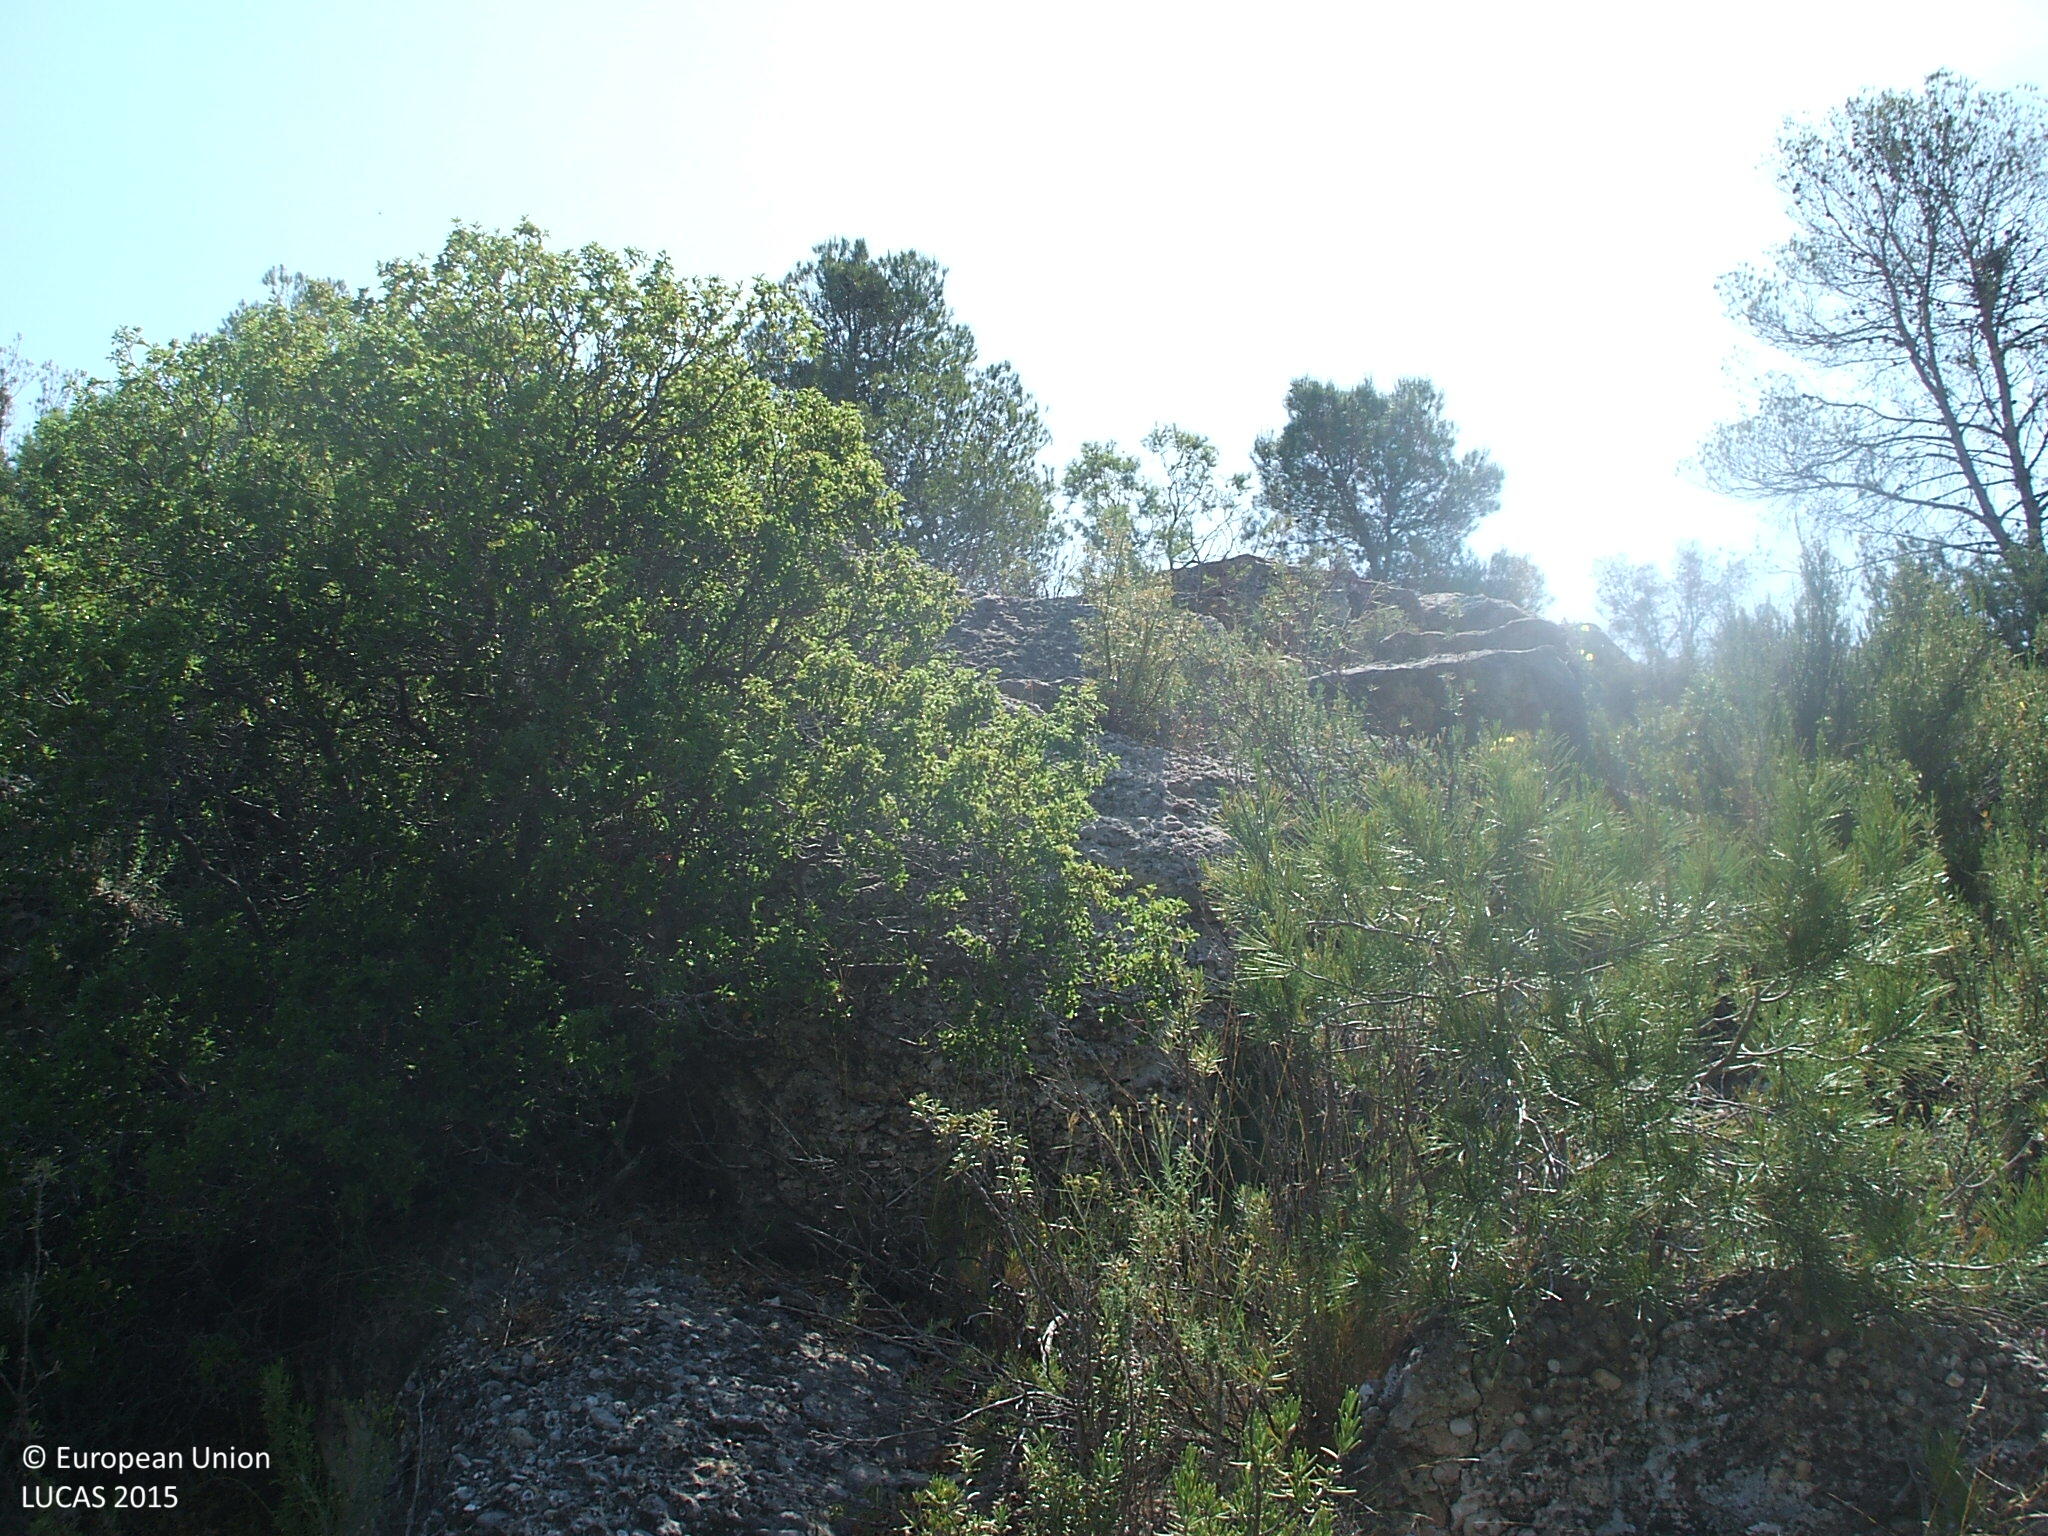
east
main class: Woodland
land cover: Pine dominated coniferous woodland
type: coniferous forest of the mediterranean region
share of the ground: 50 - 75 %
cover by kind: coniferous forest trees 70 %, shrubs 30 %
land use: Semi-natural and natural areas not in use
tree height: > 5 m
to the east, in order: Pine dominated coniferous woodland
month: June
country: ES
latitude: 40.9223
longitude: -0.1631
